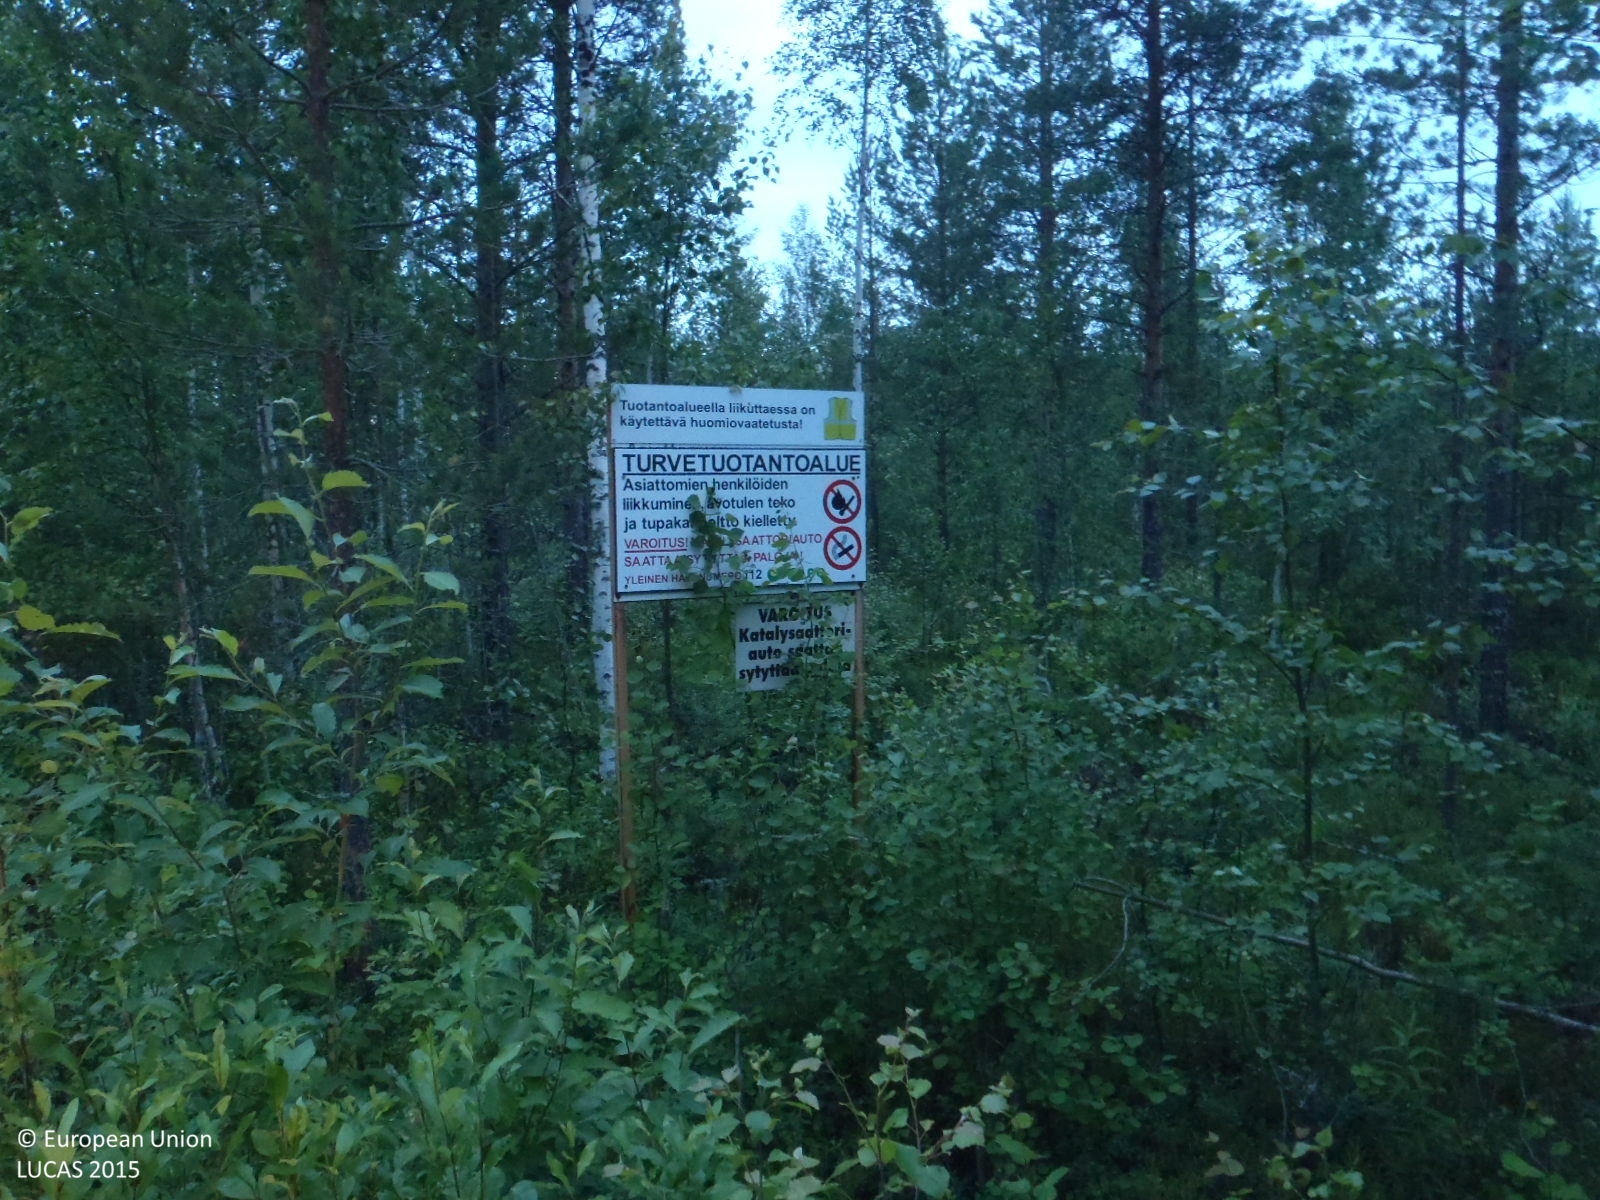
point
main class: Woodland
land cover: Pine dominated mixed woodland
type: boreal forest
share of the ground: 50 - 75 %
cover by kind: coniferous forest trees 40 %, broadleaved forest trees 30 %, shrubs 25 %, lichens and mosses 5 %
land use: Forestry
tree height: > 5 m
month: July
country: FI
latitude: 64.3247
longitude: 26.4789
